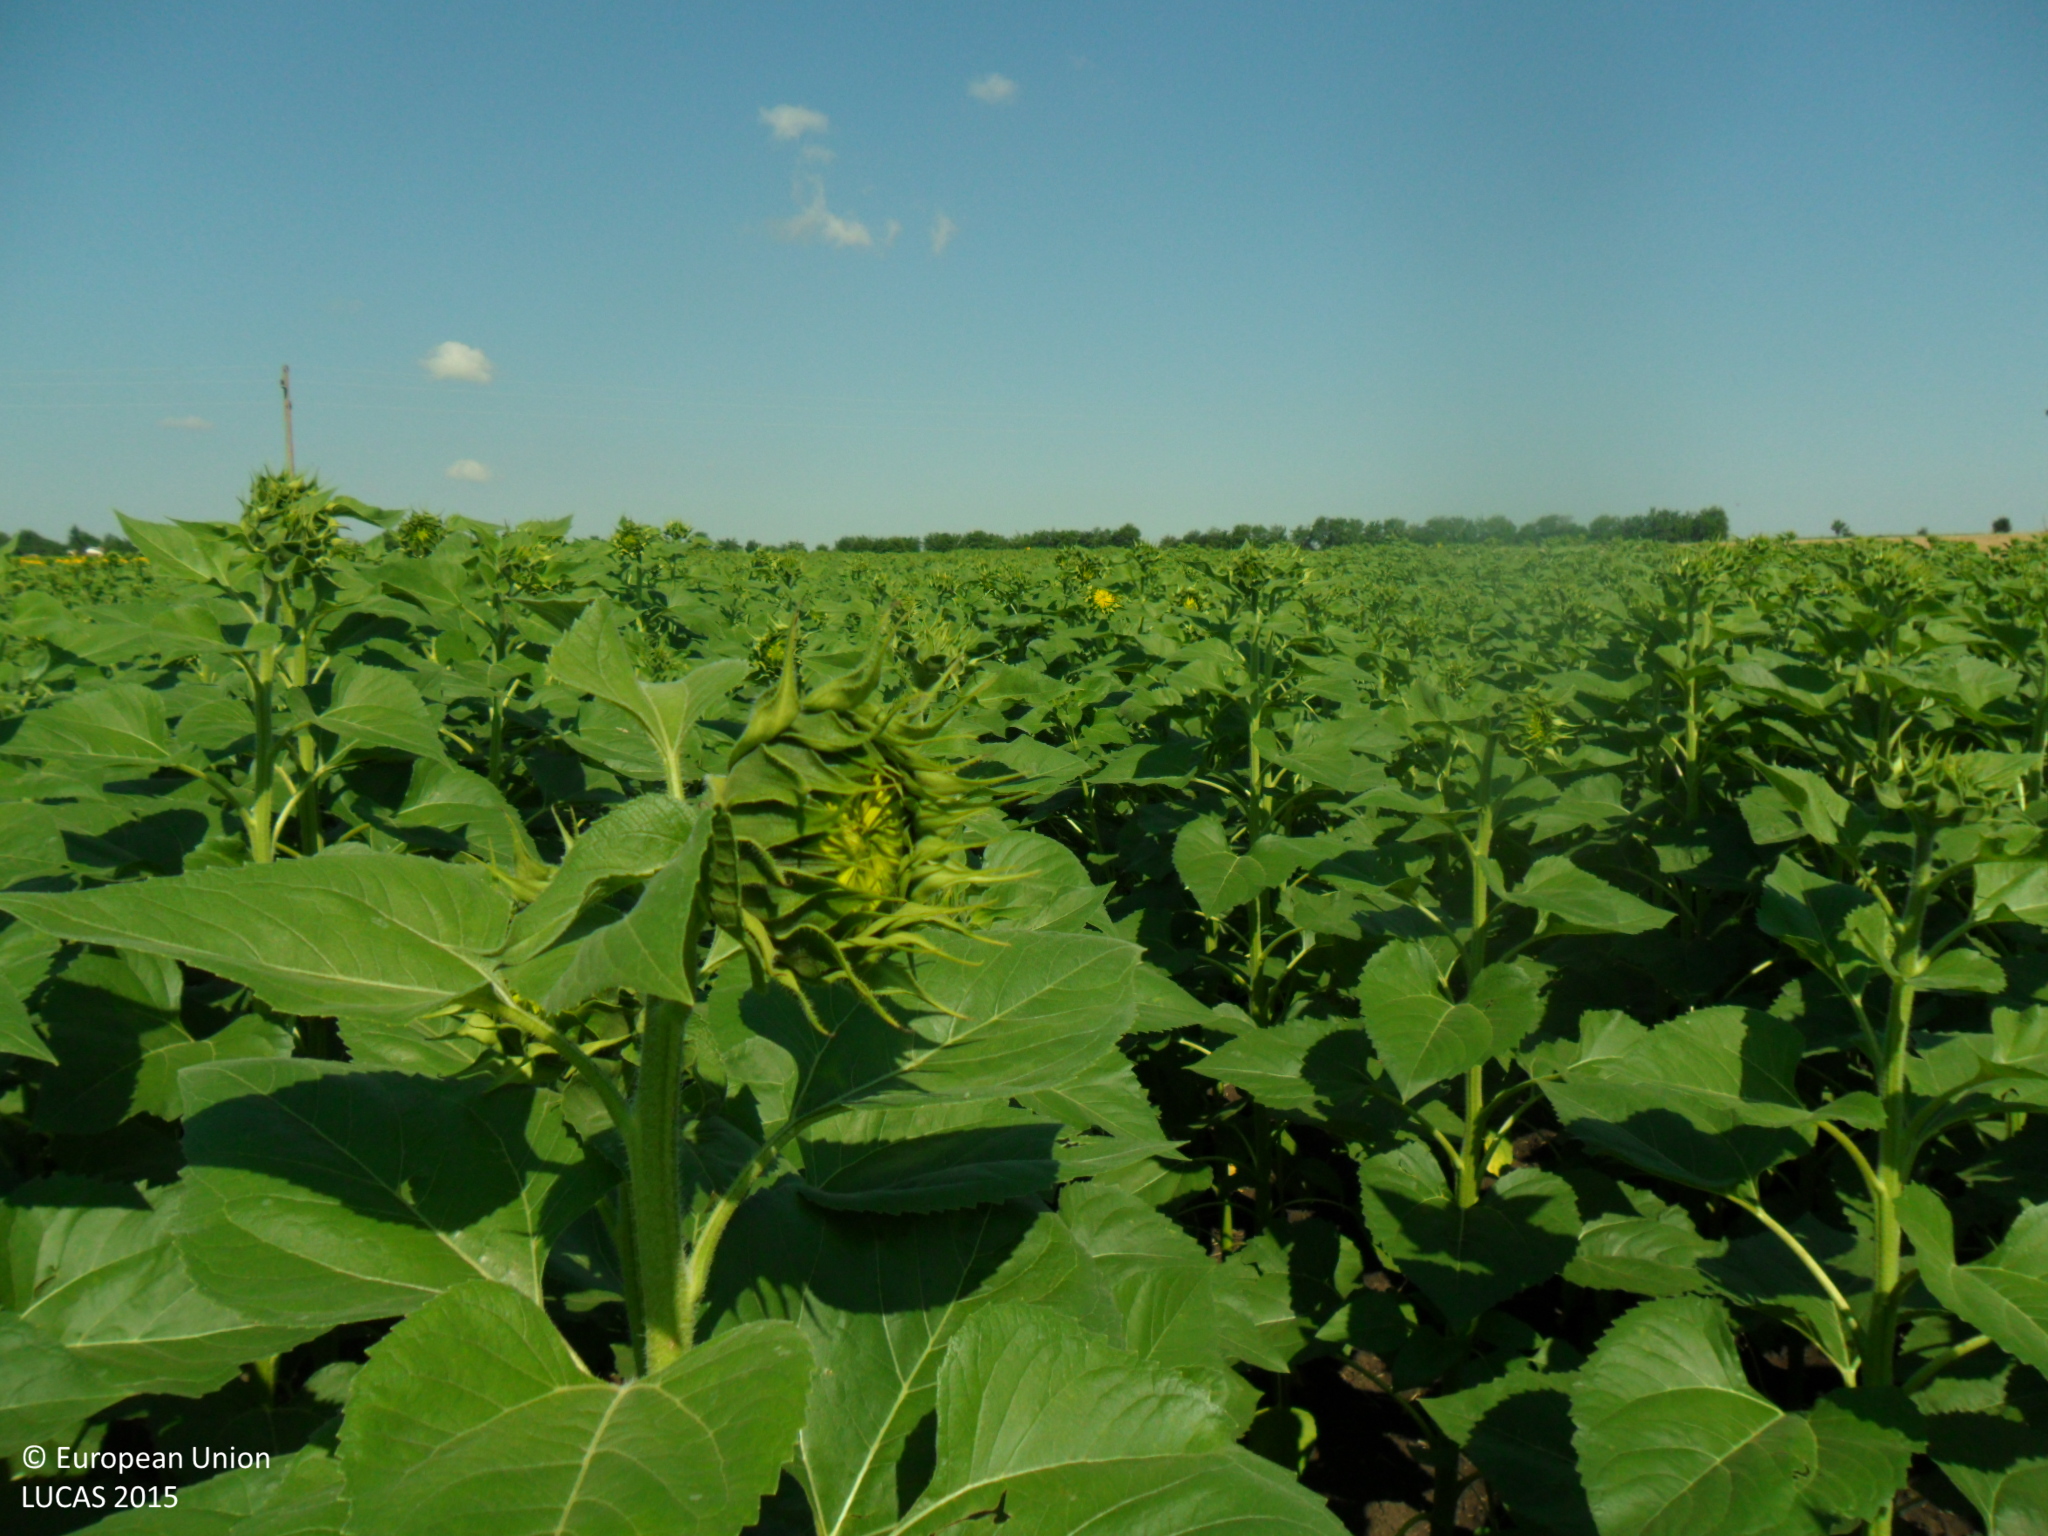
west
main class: Cropland
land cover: Sunflower
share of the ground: > 75 %
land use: Agriculture (excluding fallow land and kitchen gardens)
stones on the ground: < 10 %
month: June
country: BG
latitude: 43.3357
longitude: 27.0261
